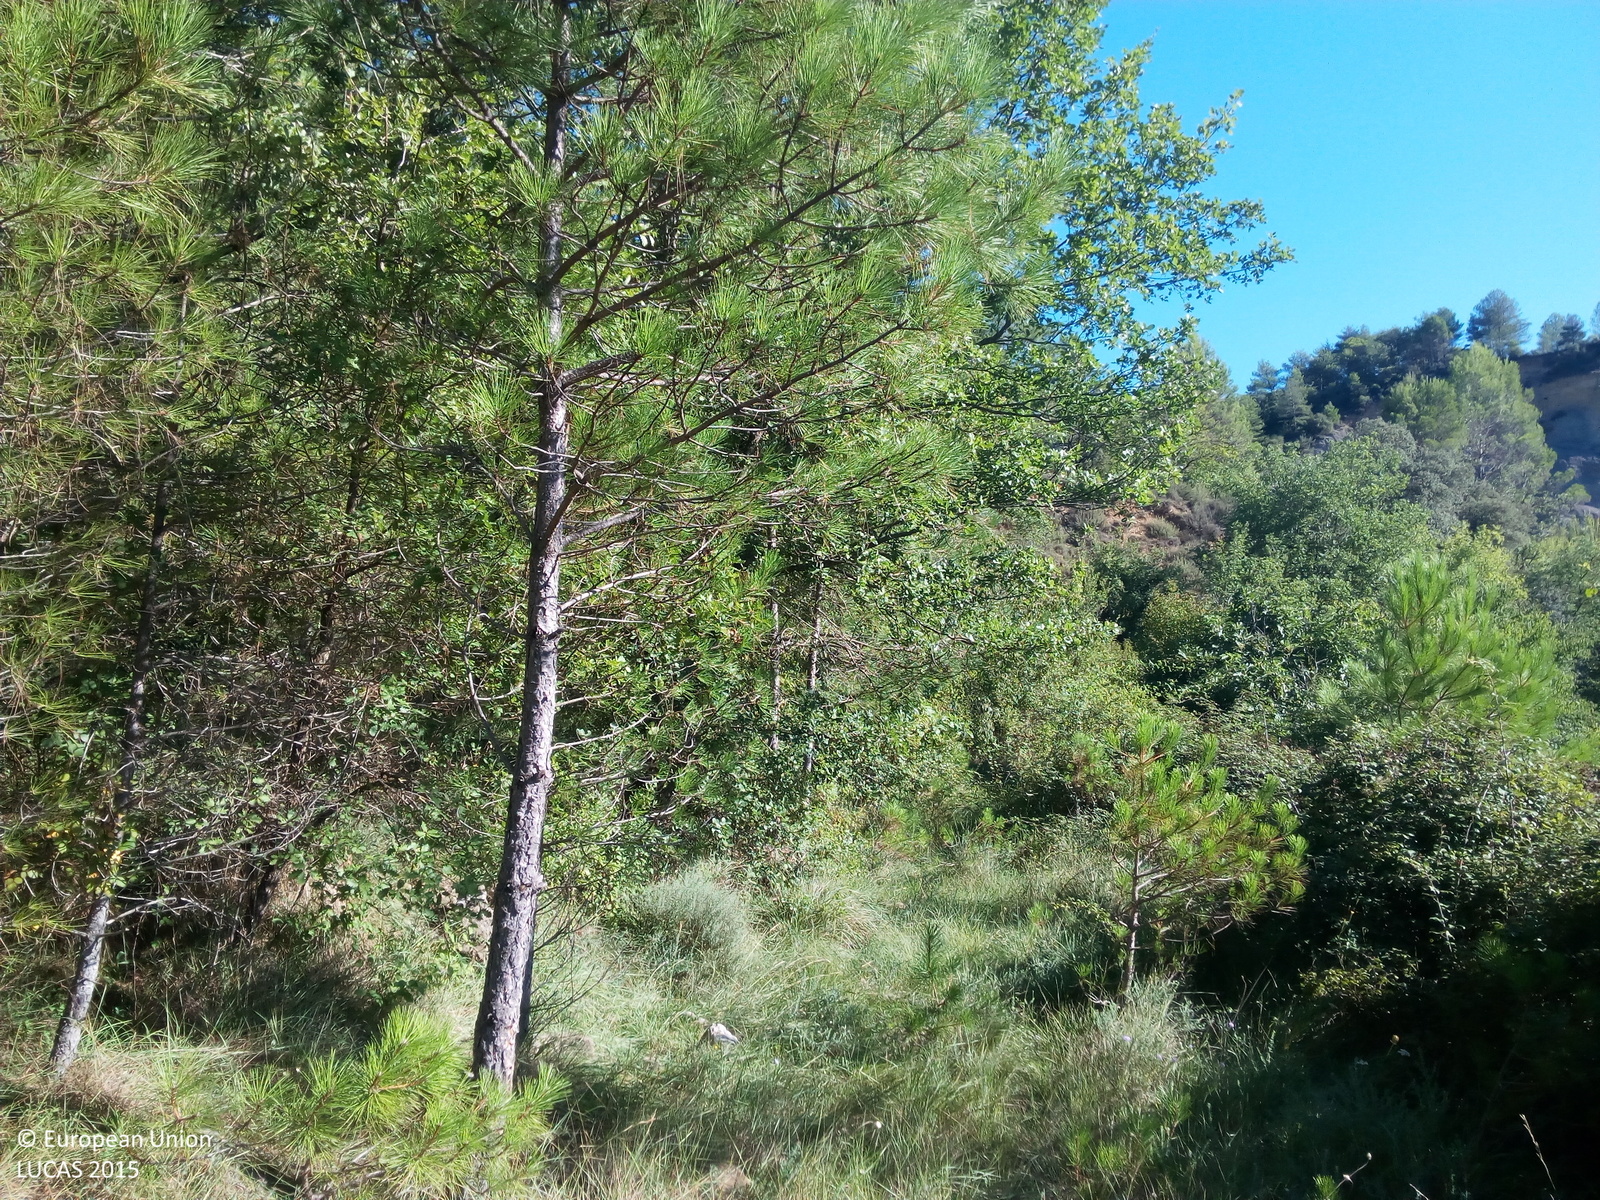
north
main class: Woodland
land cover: Pine dominated mixed woodland
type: alpine coniferous forest
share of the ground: > 75 %
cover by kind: coniferous forest trees 40 %, broadleaved forest trees 30 %, shrubs 20 %, consolidated bare surface 10 %
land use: Semi-natural and natural areas not in use
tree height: > 5 m
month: August
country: ES
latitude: 42.4161
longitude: 0.2211
